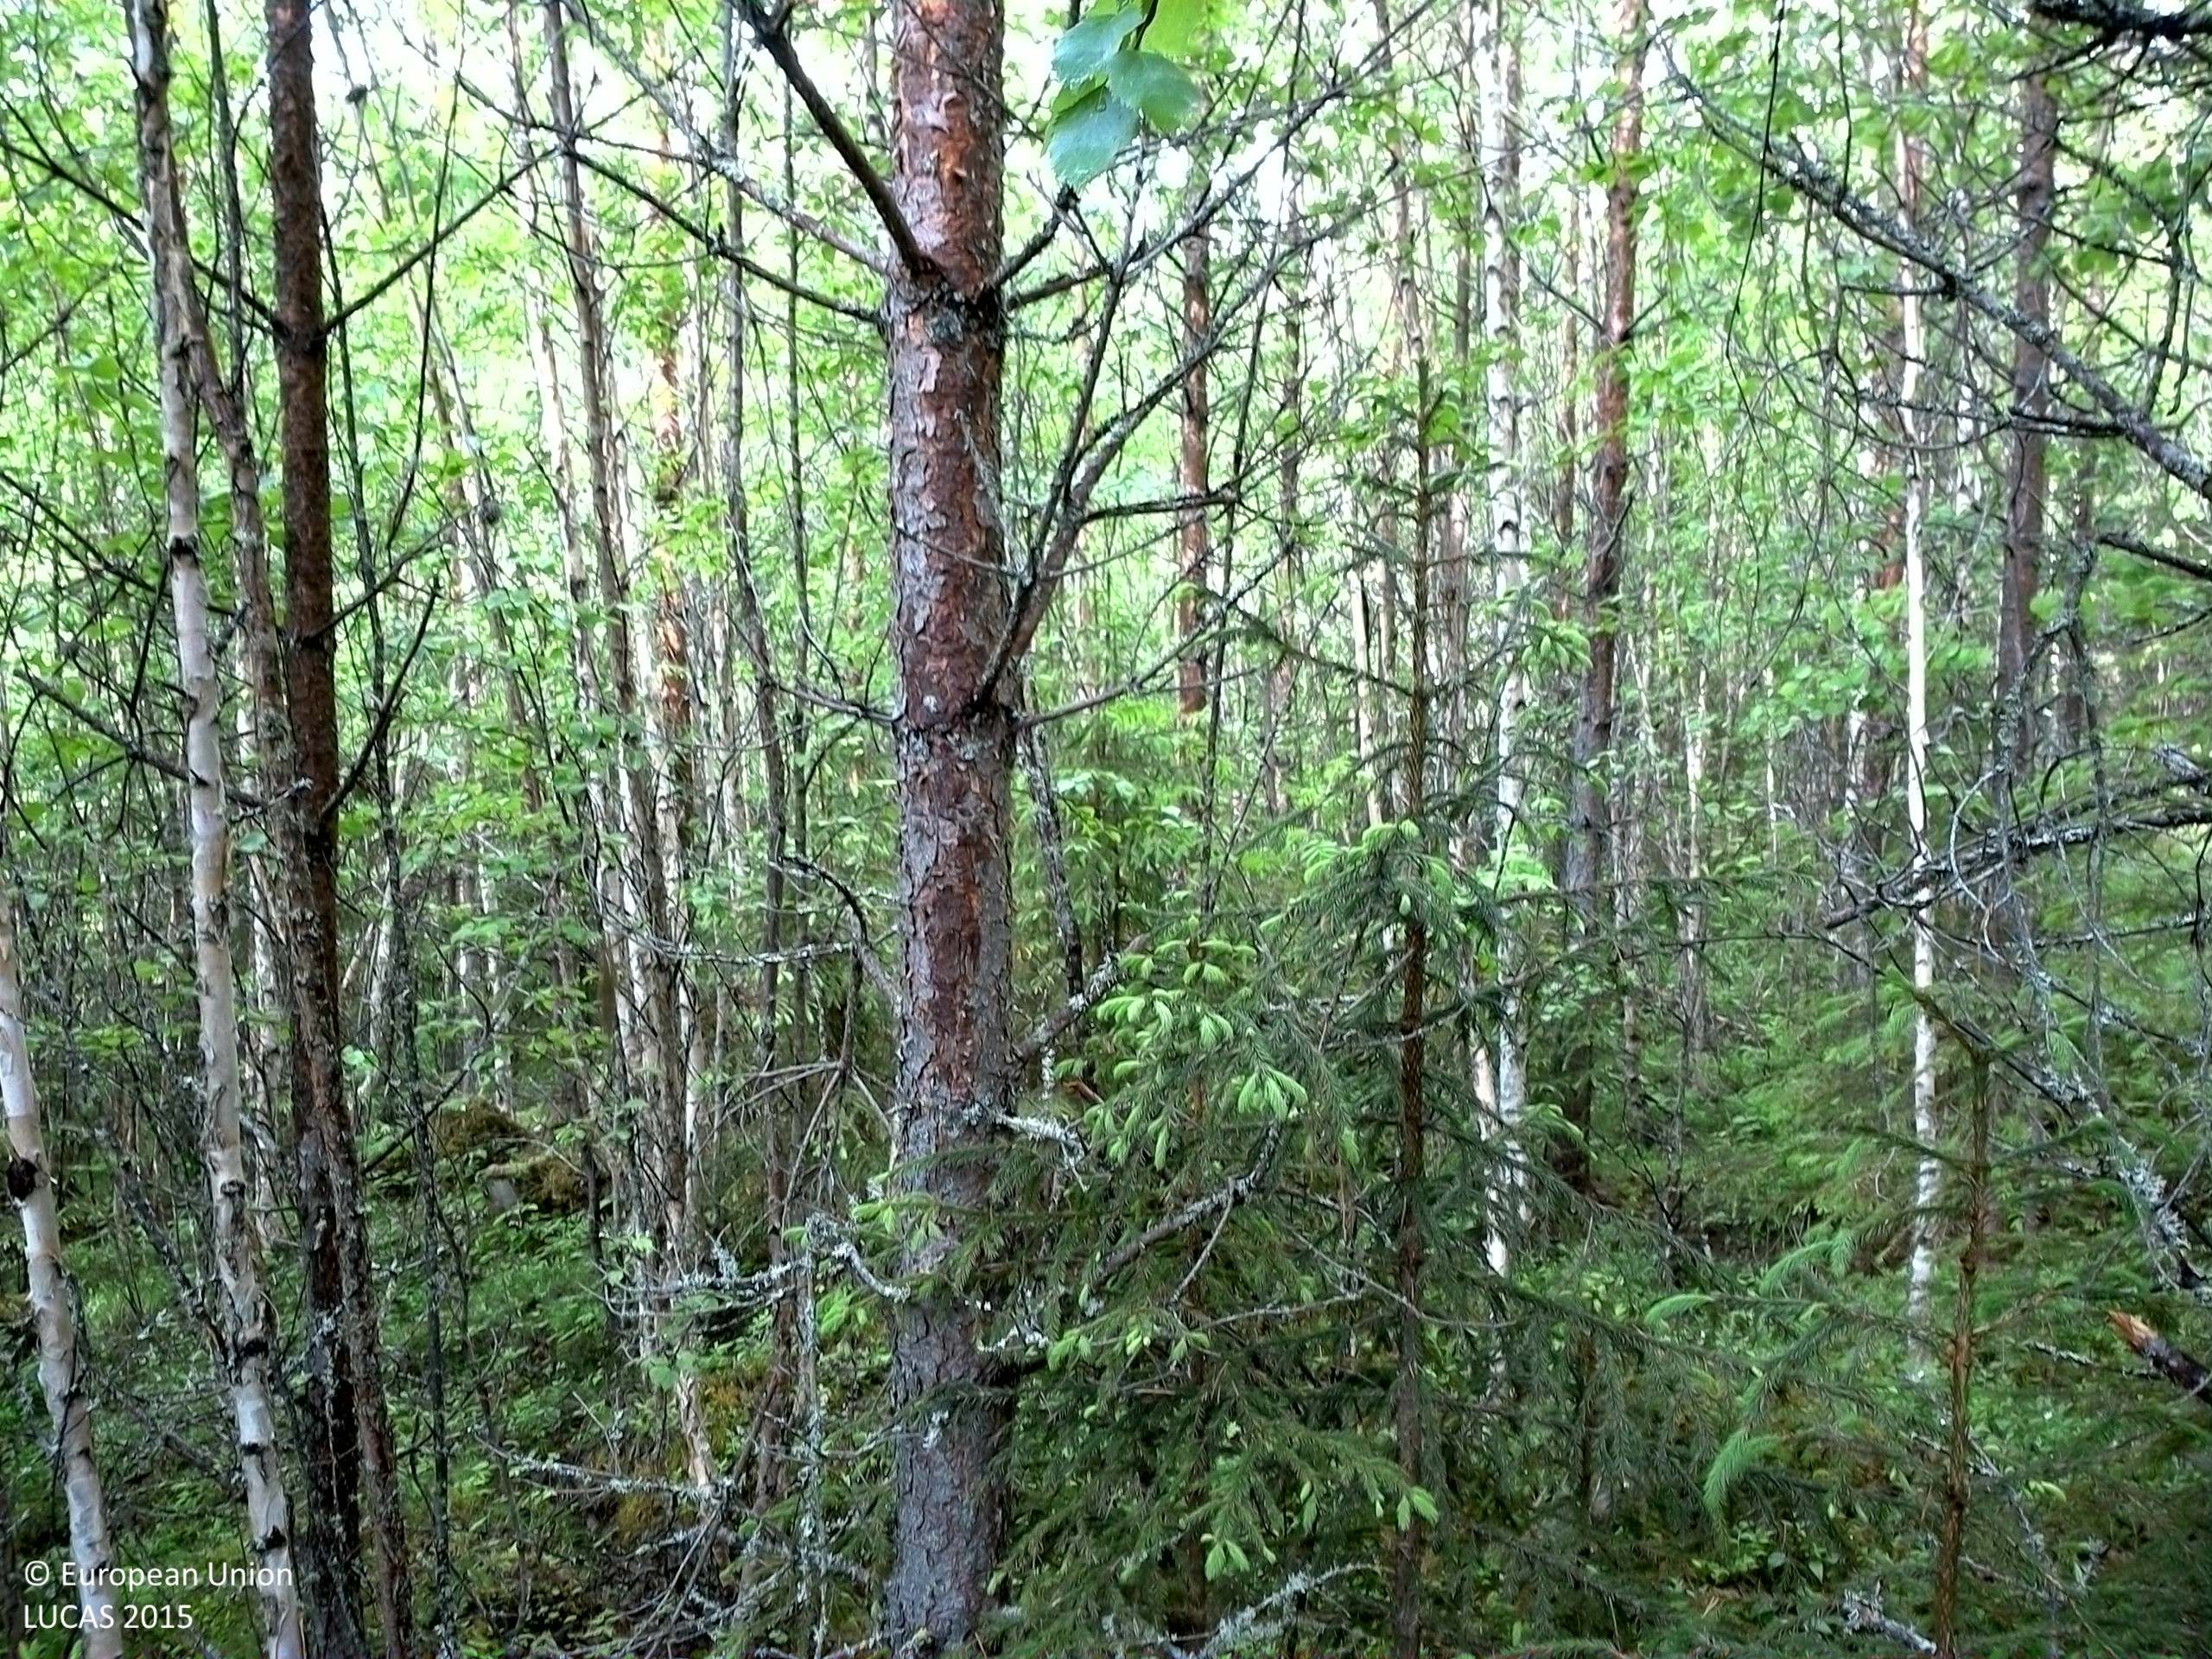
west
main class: Woodland
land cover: Pine dominated mixed woodland
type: boreal forest
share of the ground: 50 - 75 %
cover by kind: coniferous forest trees 40 %, broadleaved forest trees 30 %, shrubs 25 %, lichens and mosses 5 %
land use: Forestry
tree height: > 5 m
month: June
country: SE
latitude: 63.4847
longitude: 18.0661
